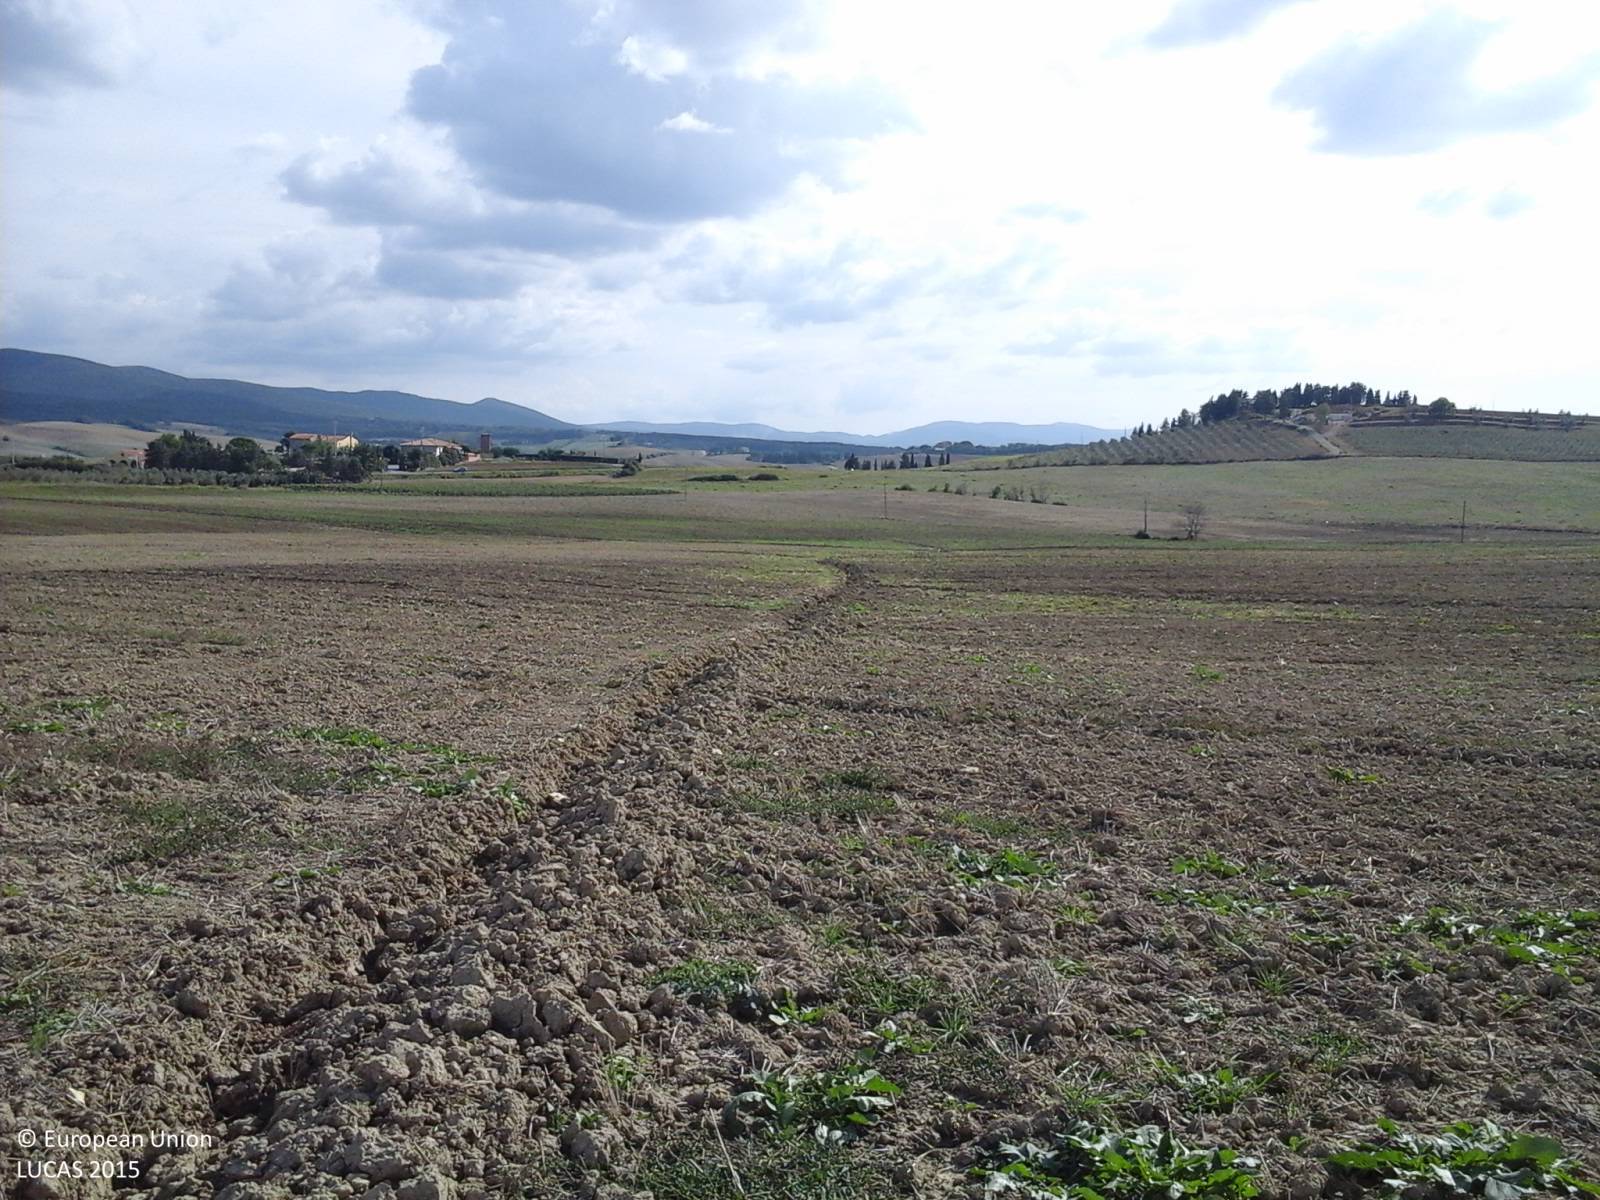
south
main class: Cropland
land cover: Durum wheat
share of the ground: < 10 %
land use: Agriculture (excluding fallow land and kitchen gardens)
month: October
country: IT
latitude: 43.2842
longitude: 10.6021
